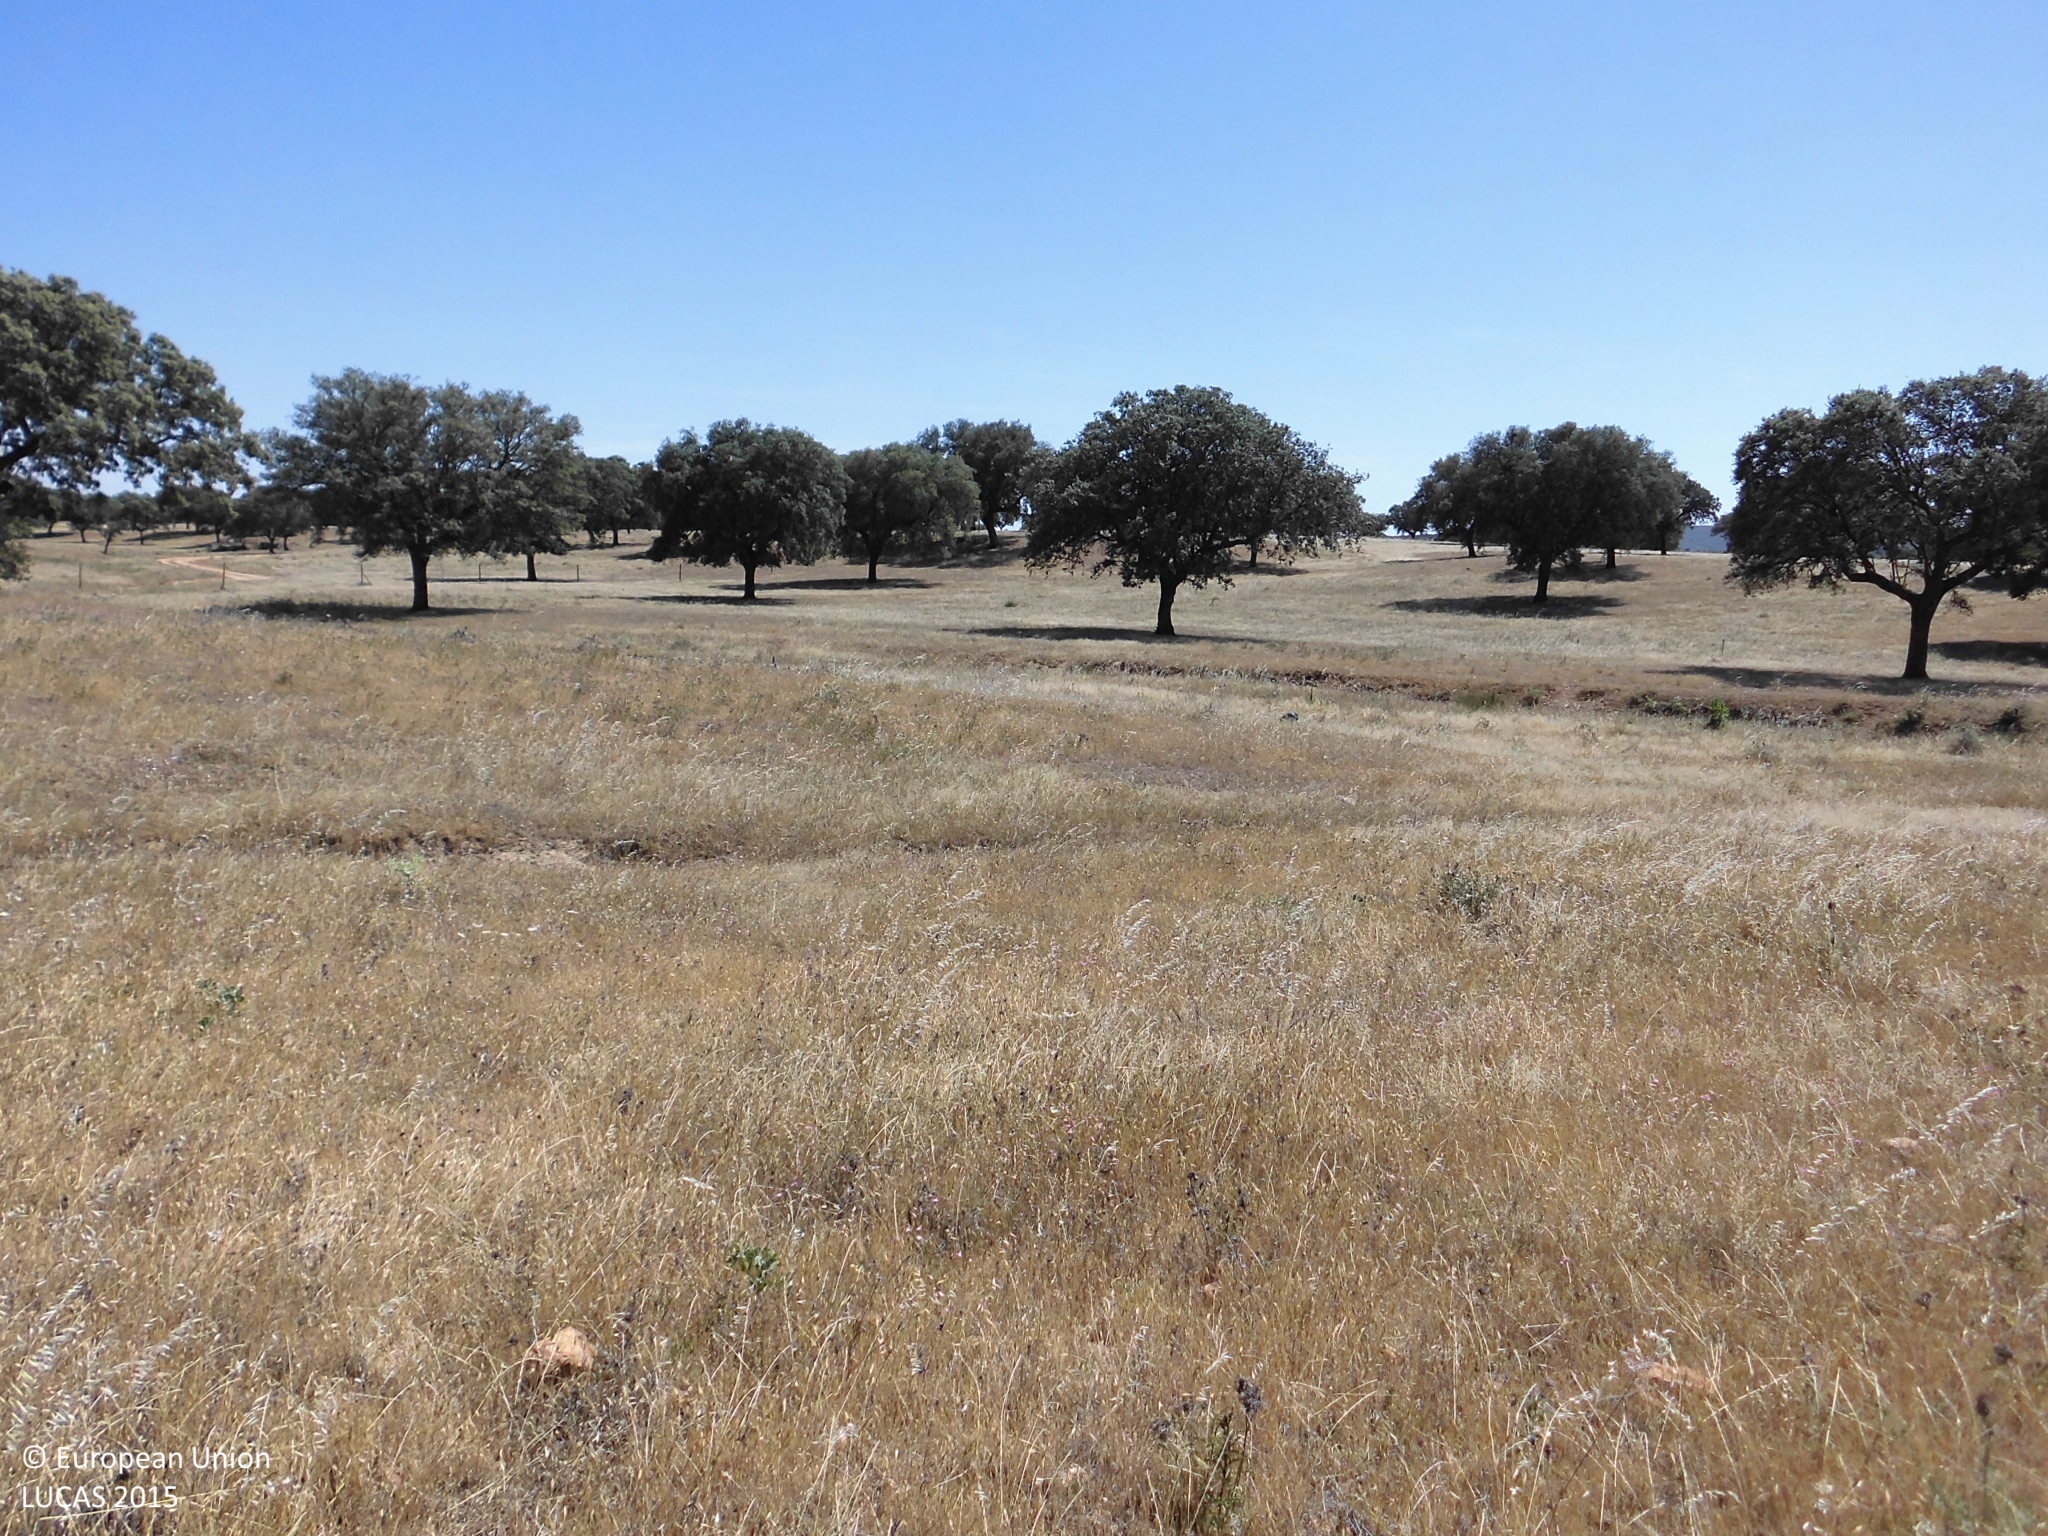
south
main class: Woodland
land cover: Broadleaved woodland
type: broadleaved evergreen forest
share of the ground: 10 - 25 %
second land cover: Grassland without tree/shrub cover
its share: > 75 %
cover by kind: herbaceous plants 90 %, broadleaved forest trees 10 %
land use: Forestry
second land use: Agriculture (excluding fallow land and kitchen gardens)
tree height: > 5 m
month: May
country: ES
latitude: 39.4131
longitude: -6.8126
